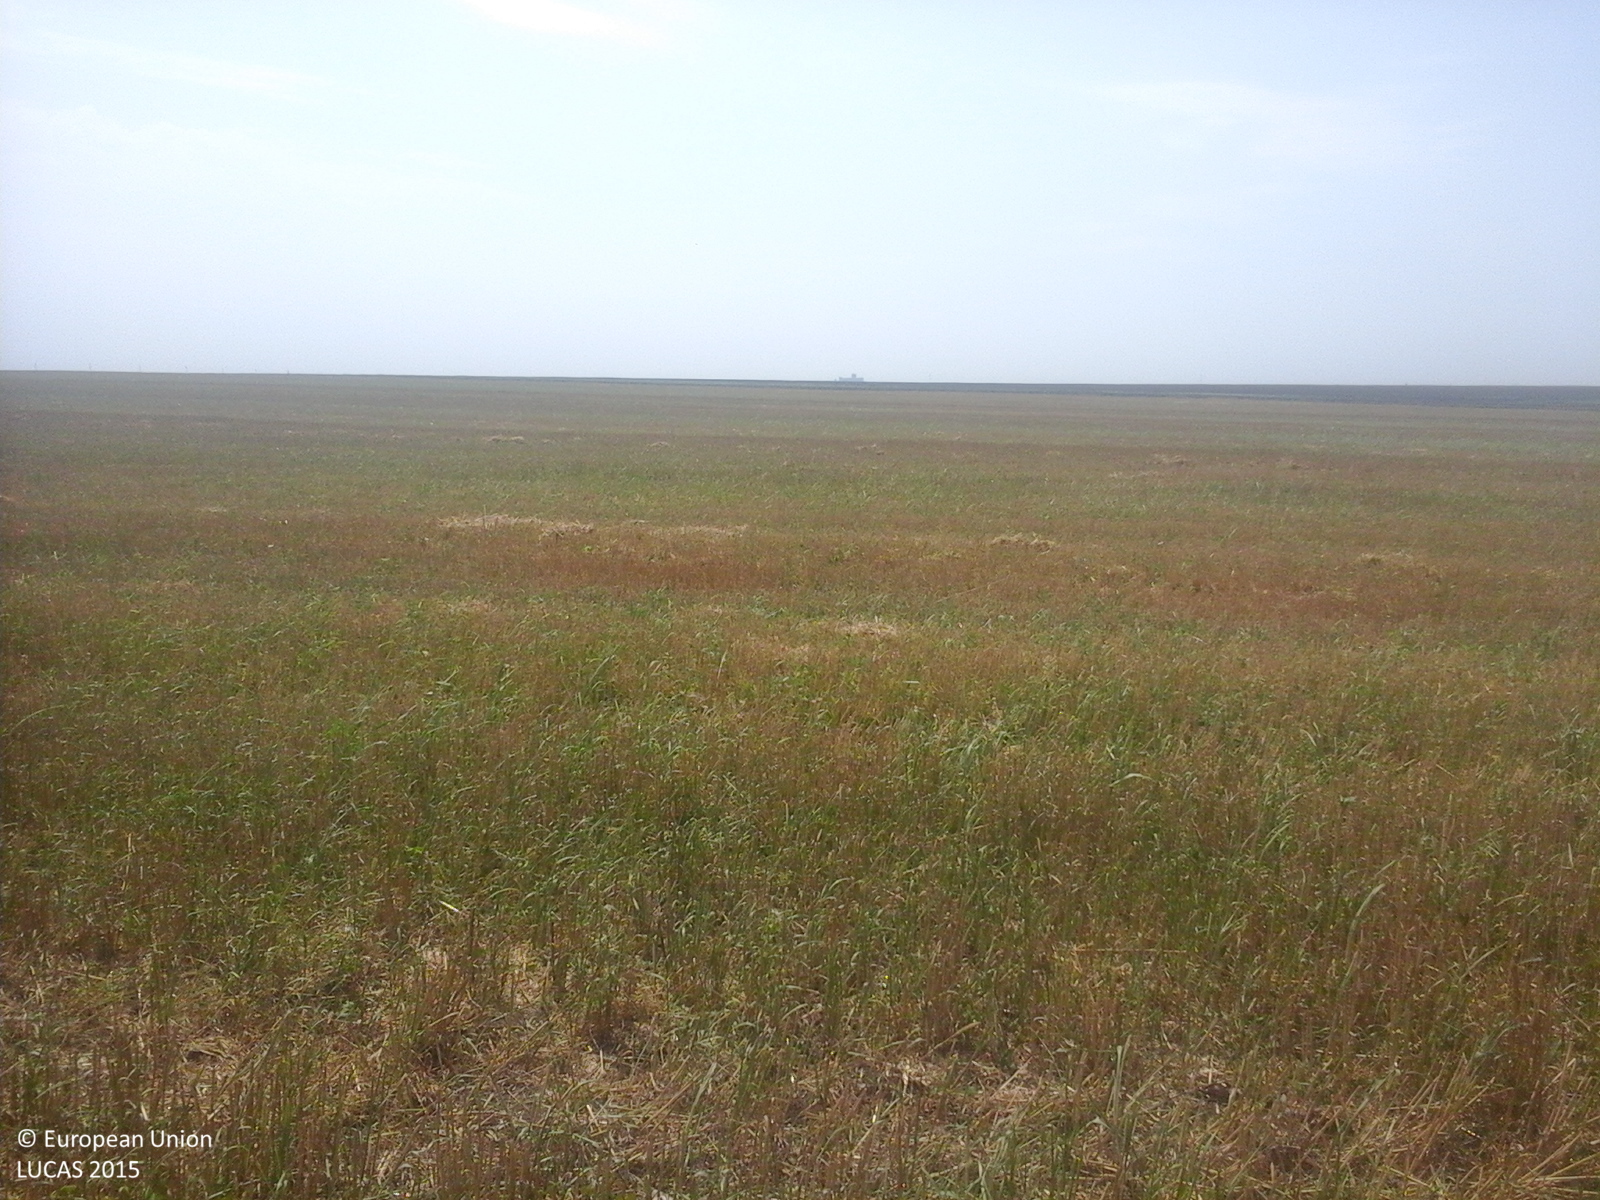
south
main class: Cropland
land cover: Durum wheat
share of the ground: > 75 %
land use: Agriculture (excluding fallow land and kitchen gardens)
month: August
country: RO
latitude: 43.8664
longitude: 28.2115
